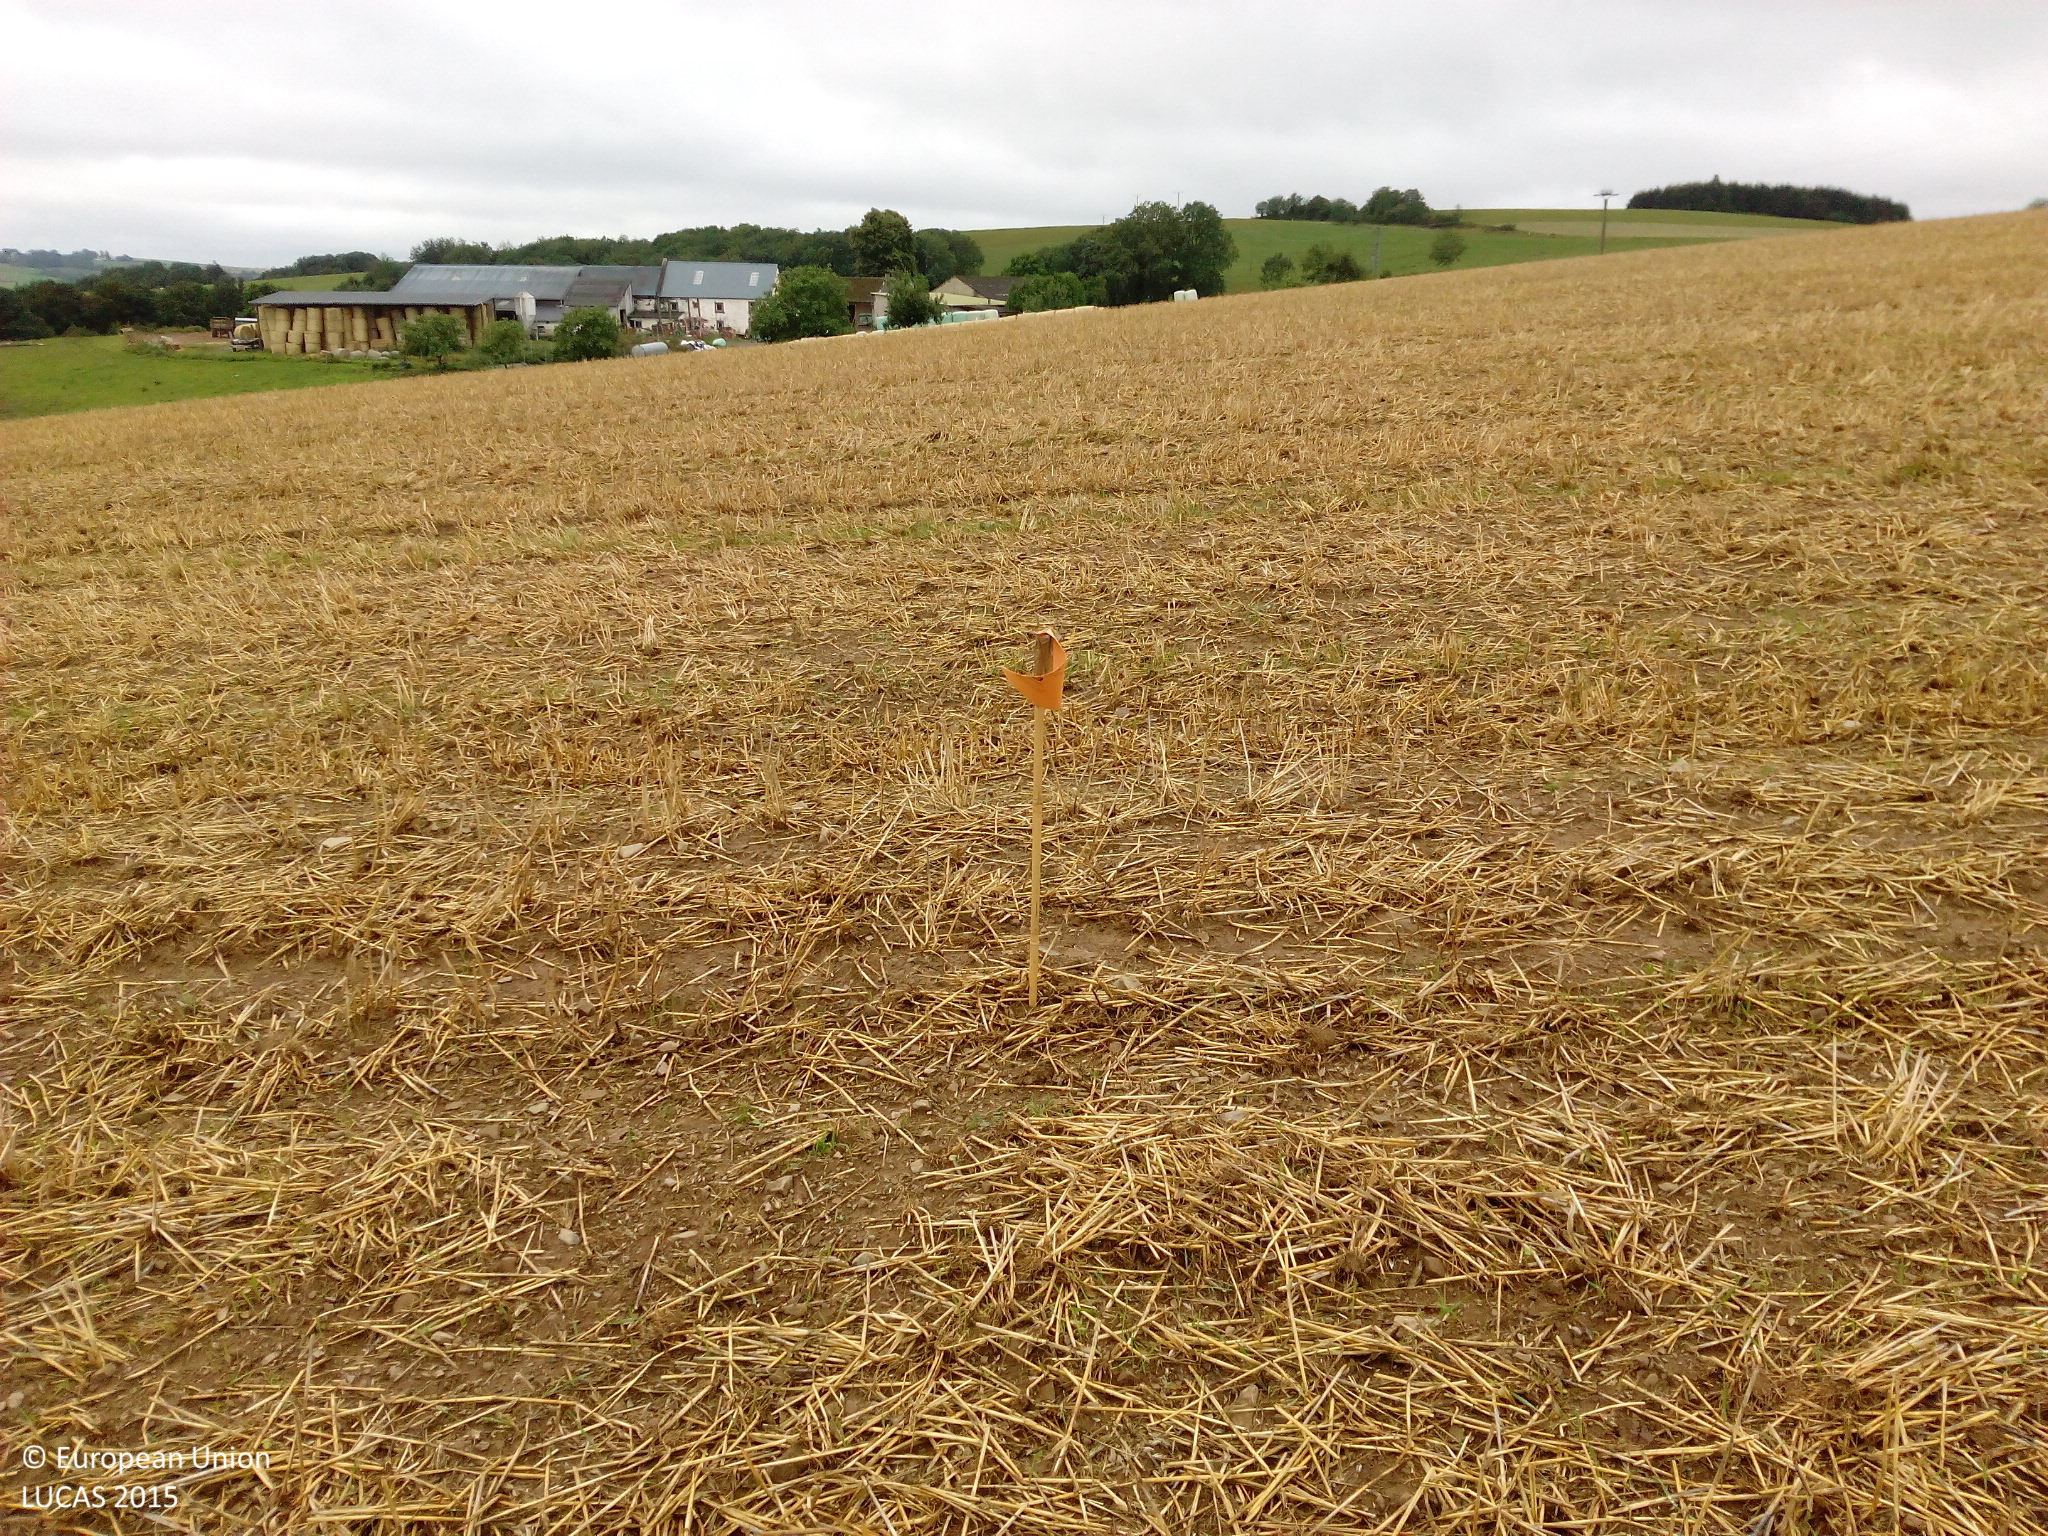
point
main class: Cropland
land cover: Rye
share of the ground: < 10 %
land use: Agriculture (excluding fallow land and kitchen gardens)
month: August
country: DE
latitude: 50.0522
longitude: 6.2984
